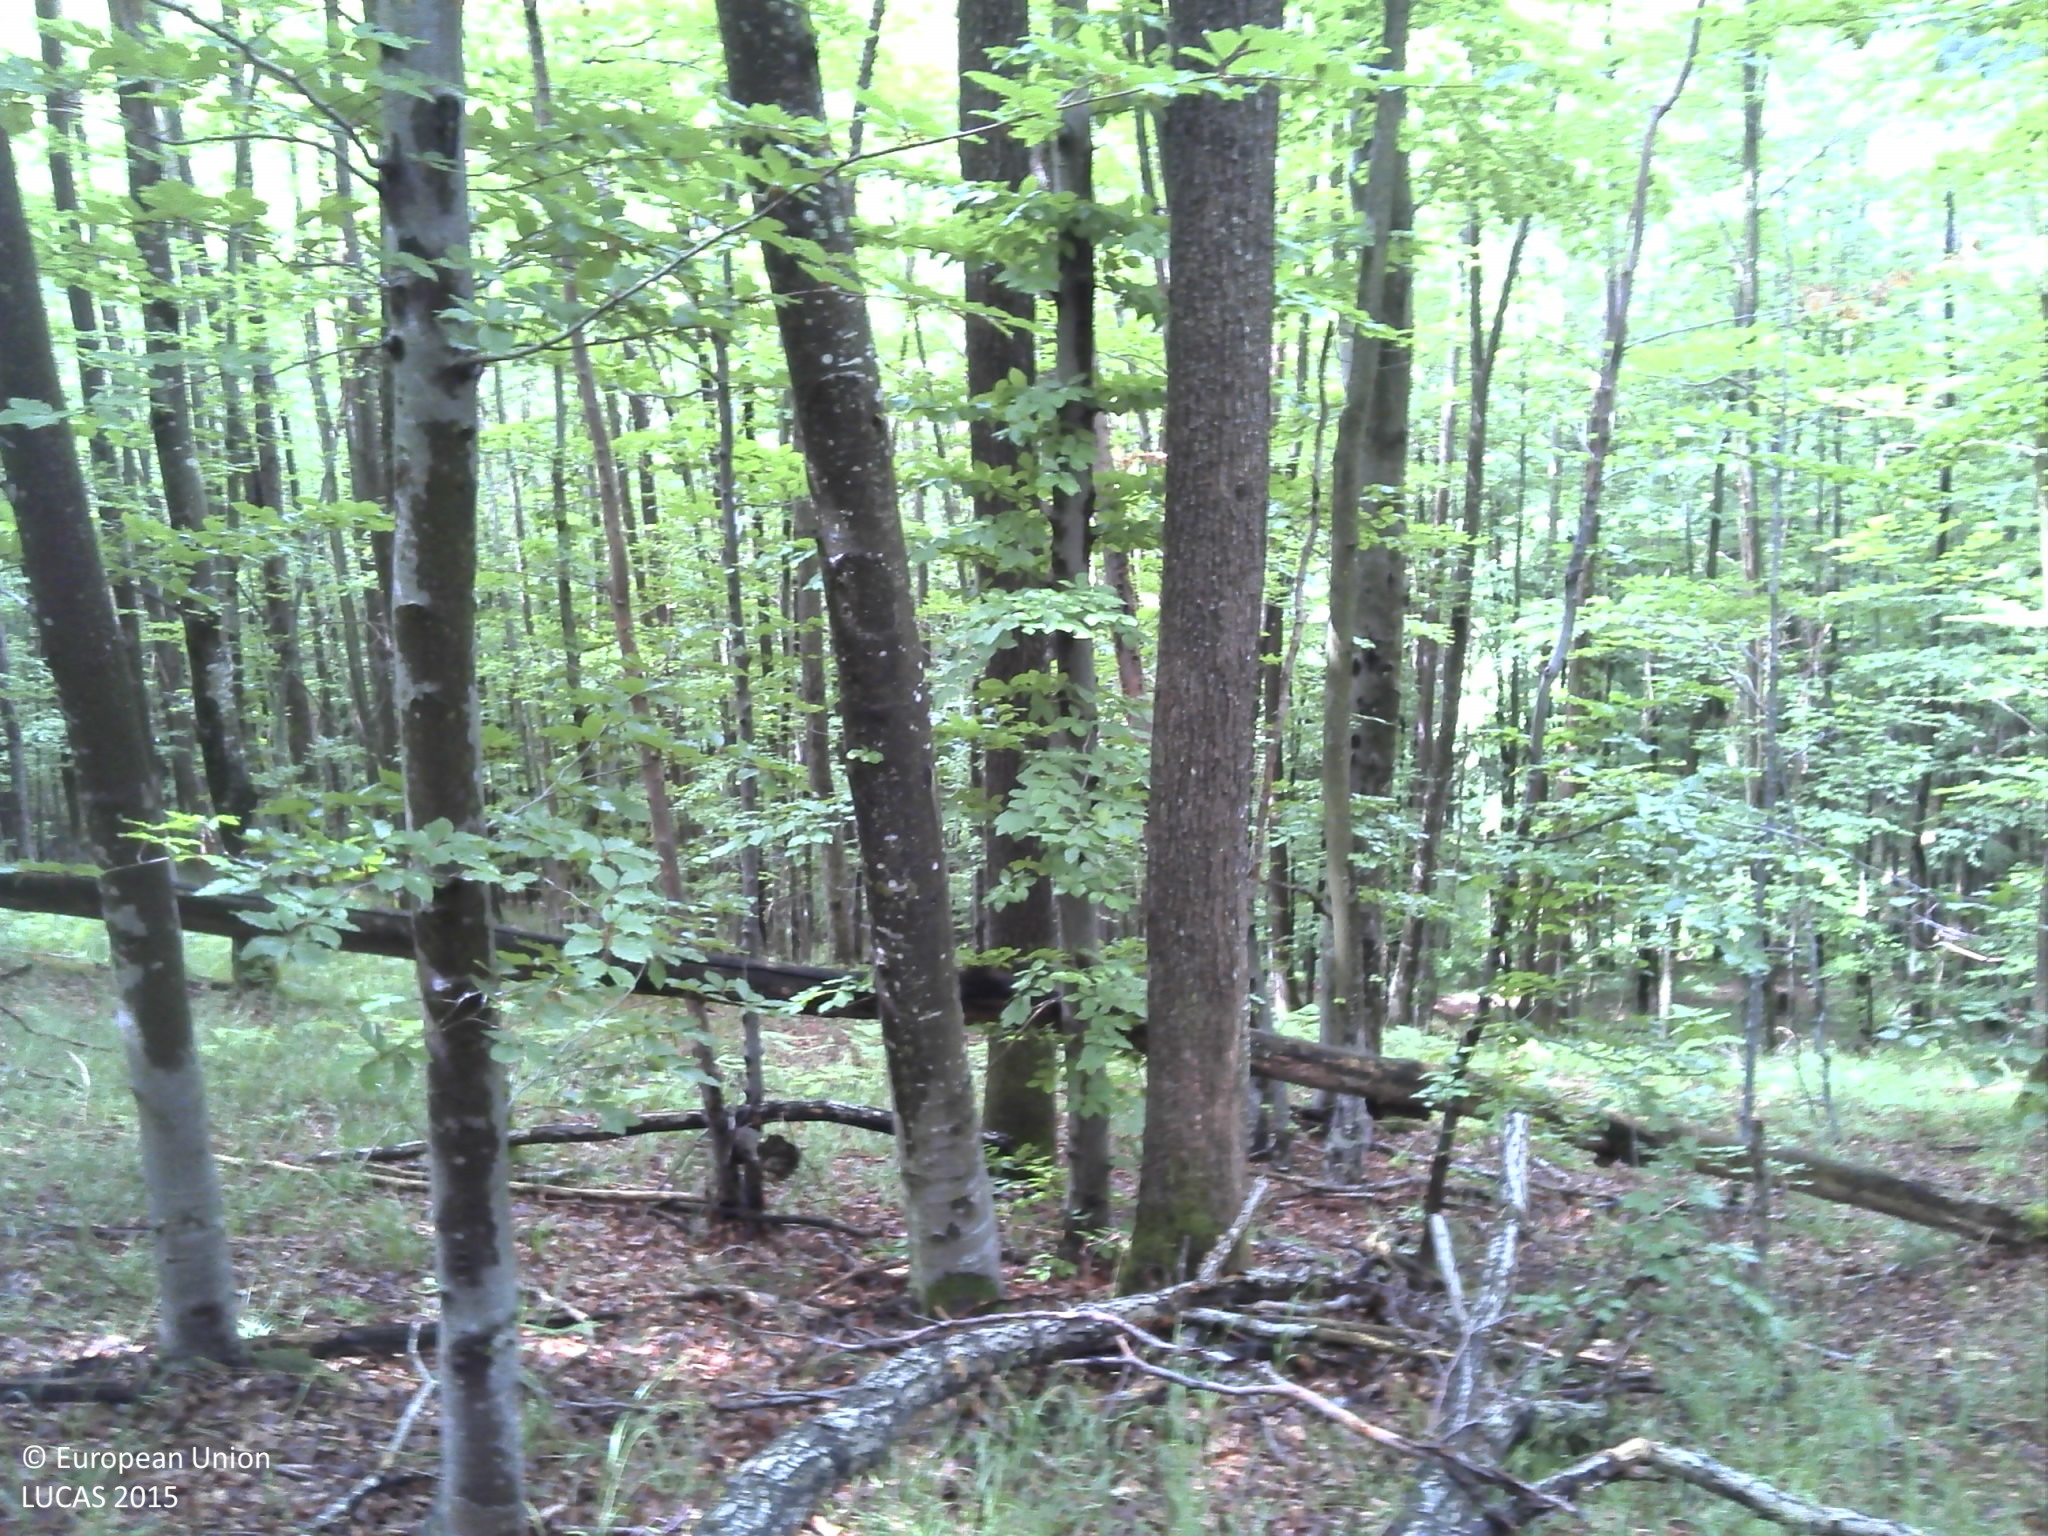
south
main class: Woodland
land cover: Broadleaved woodland
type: beech forest
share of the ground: > 75 %
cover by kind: broadleaved forest trees 80 %, lichens and mosses 20 %
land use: Forestry
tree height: > 5 m
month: June
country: HR
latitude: 45.5275
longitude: 17.4918
